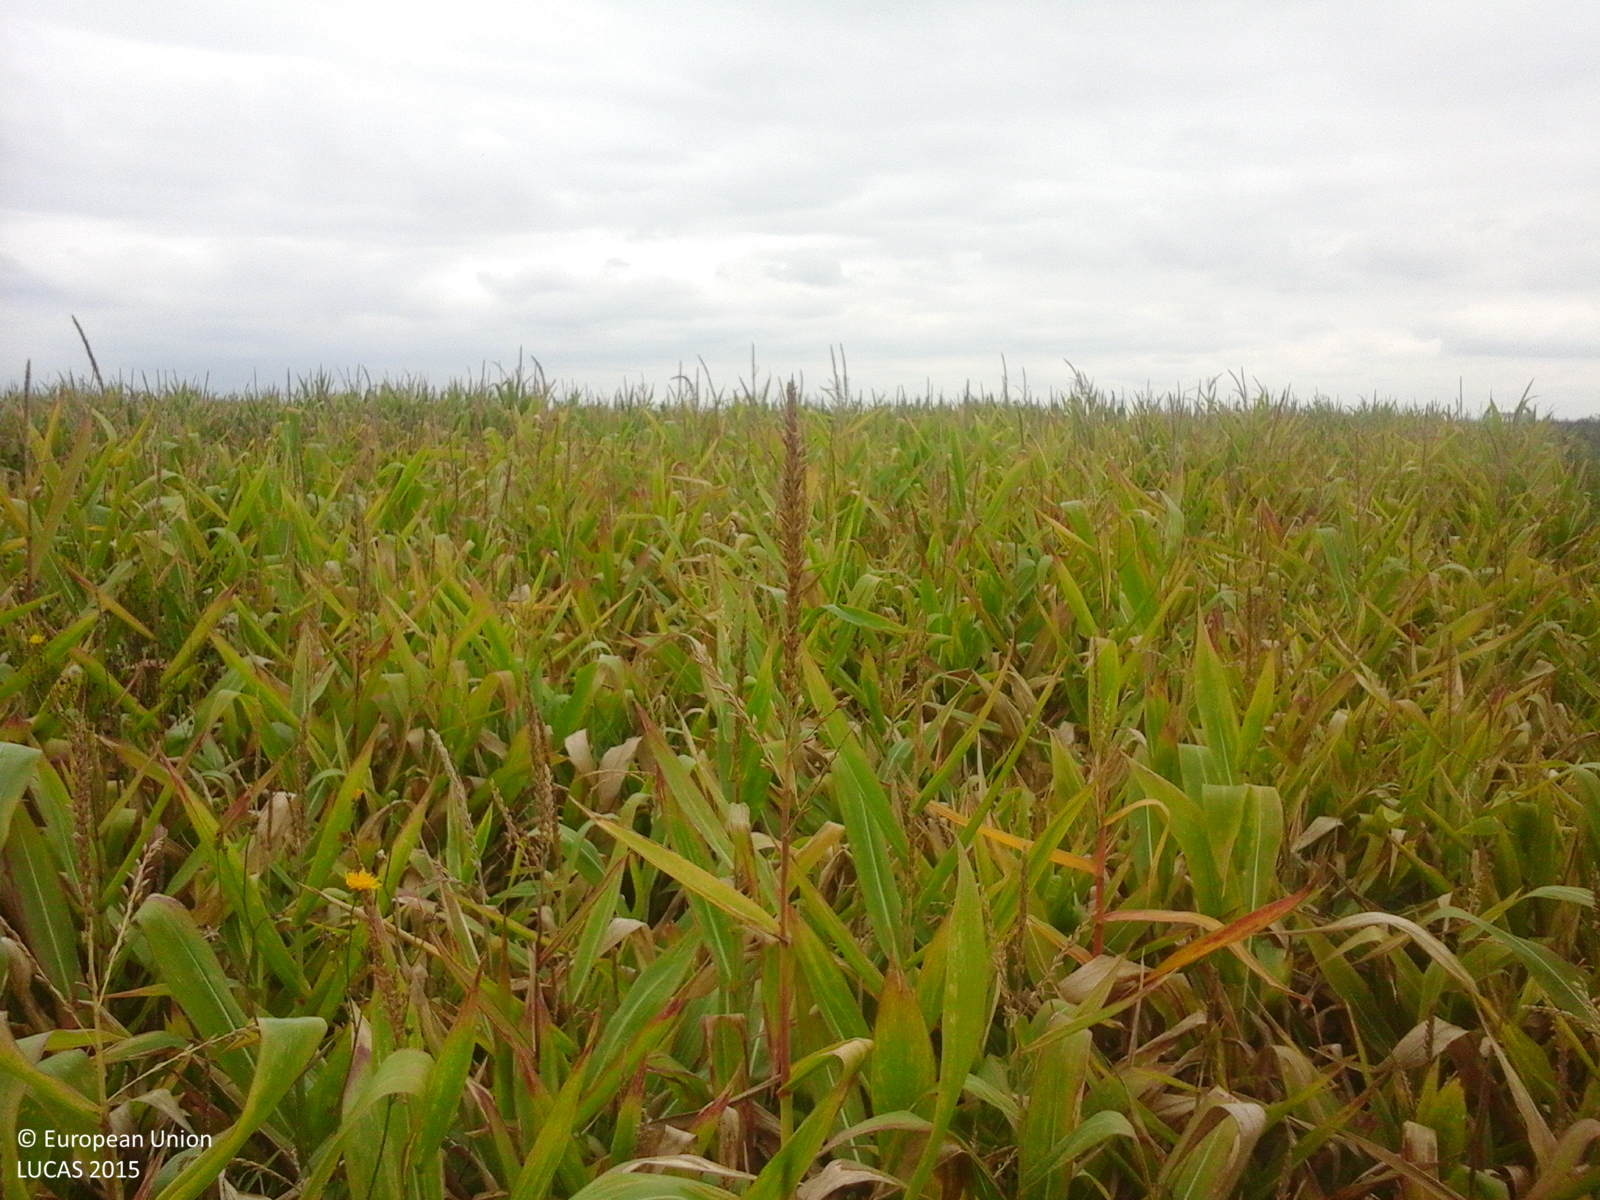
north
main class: Cropland
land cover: Maize
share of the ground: > 75 %
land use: Agriculture (excluding fallow land and kitchen gardens)
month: September
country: RO
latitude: 47.3085
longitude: 22.0196
